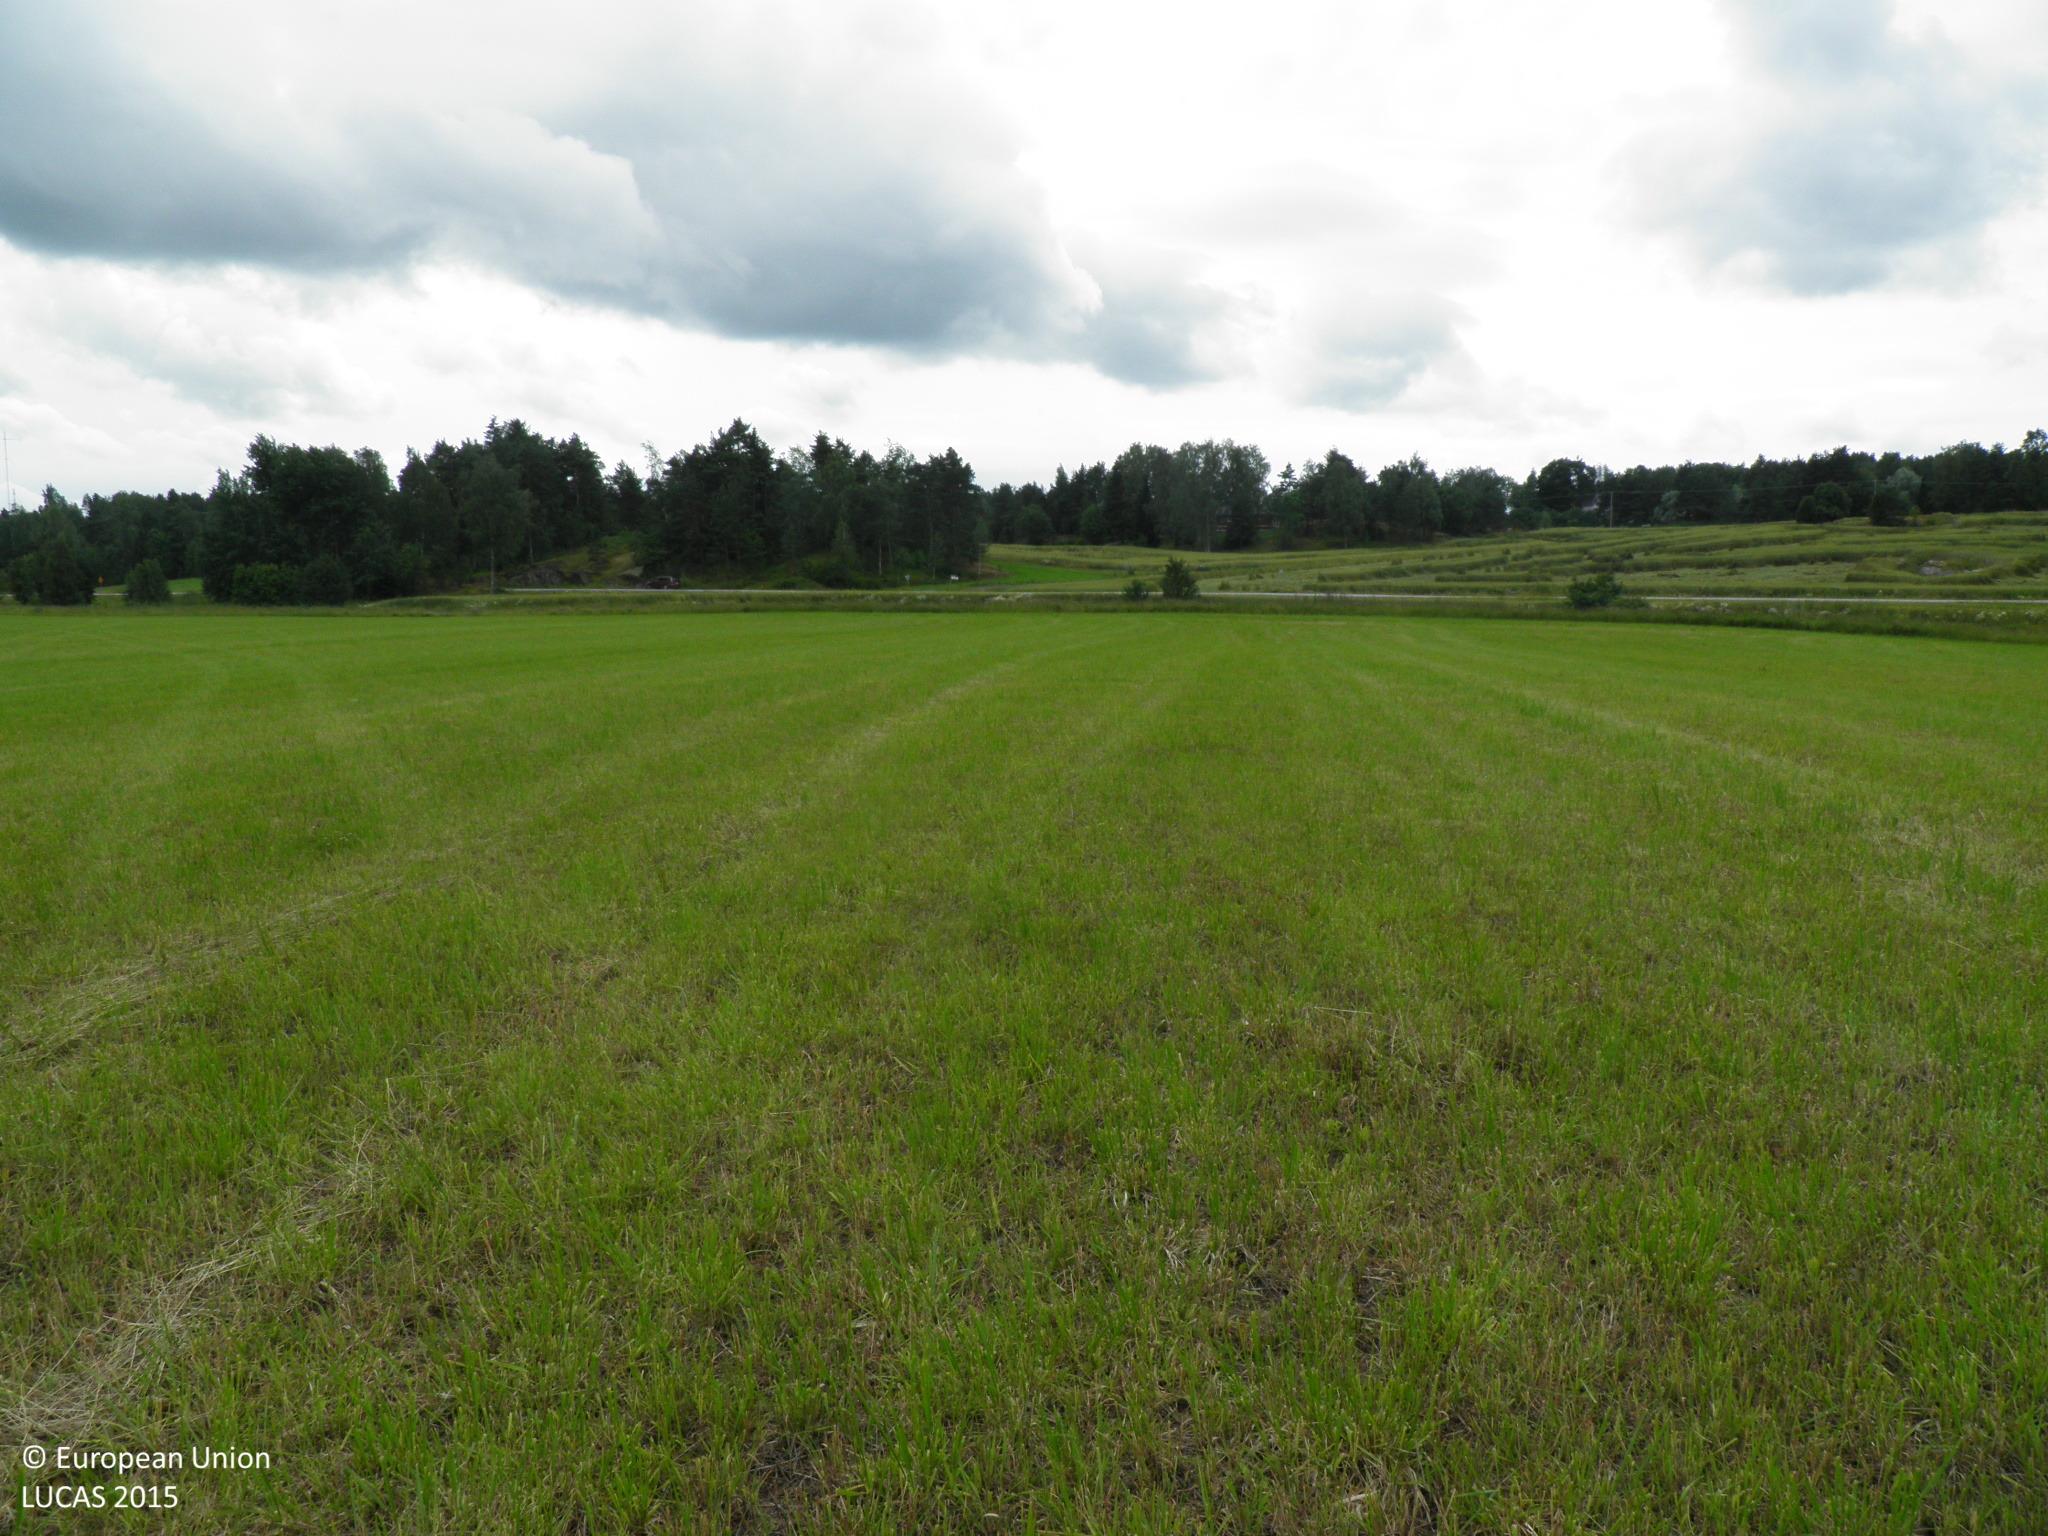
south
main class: Cropland
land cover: Temporary grasslands
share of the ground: > 75 %
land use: Agriculture (excluding fallow land and kitchen gardens)
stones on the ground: < 10 %
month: July
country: FI
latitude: 60.1868
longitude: 22.7159
